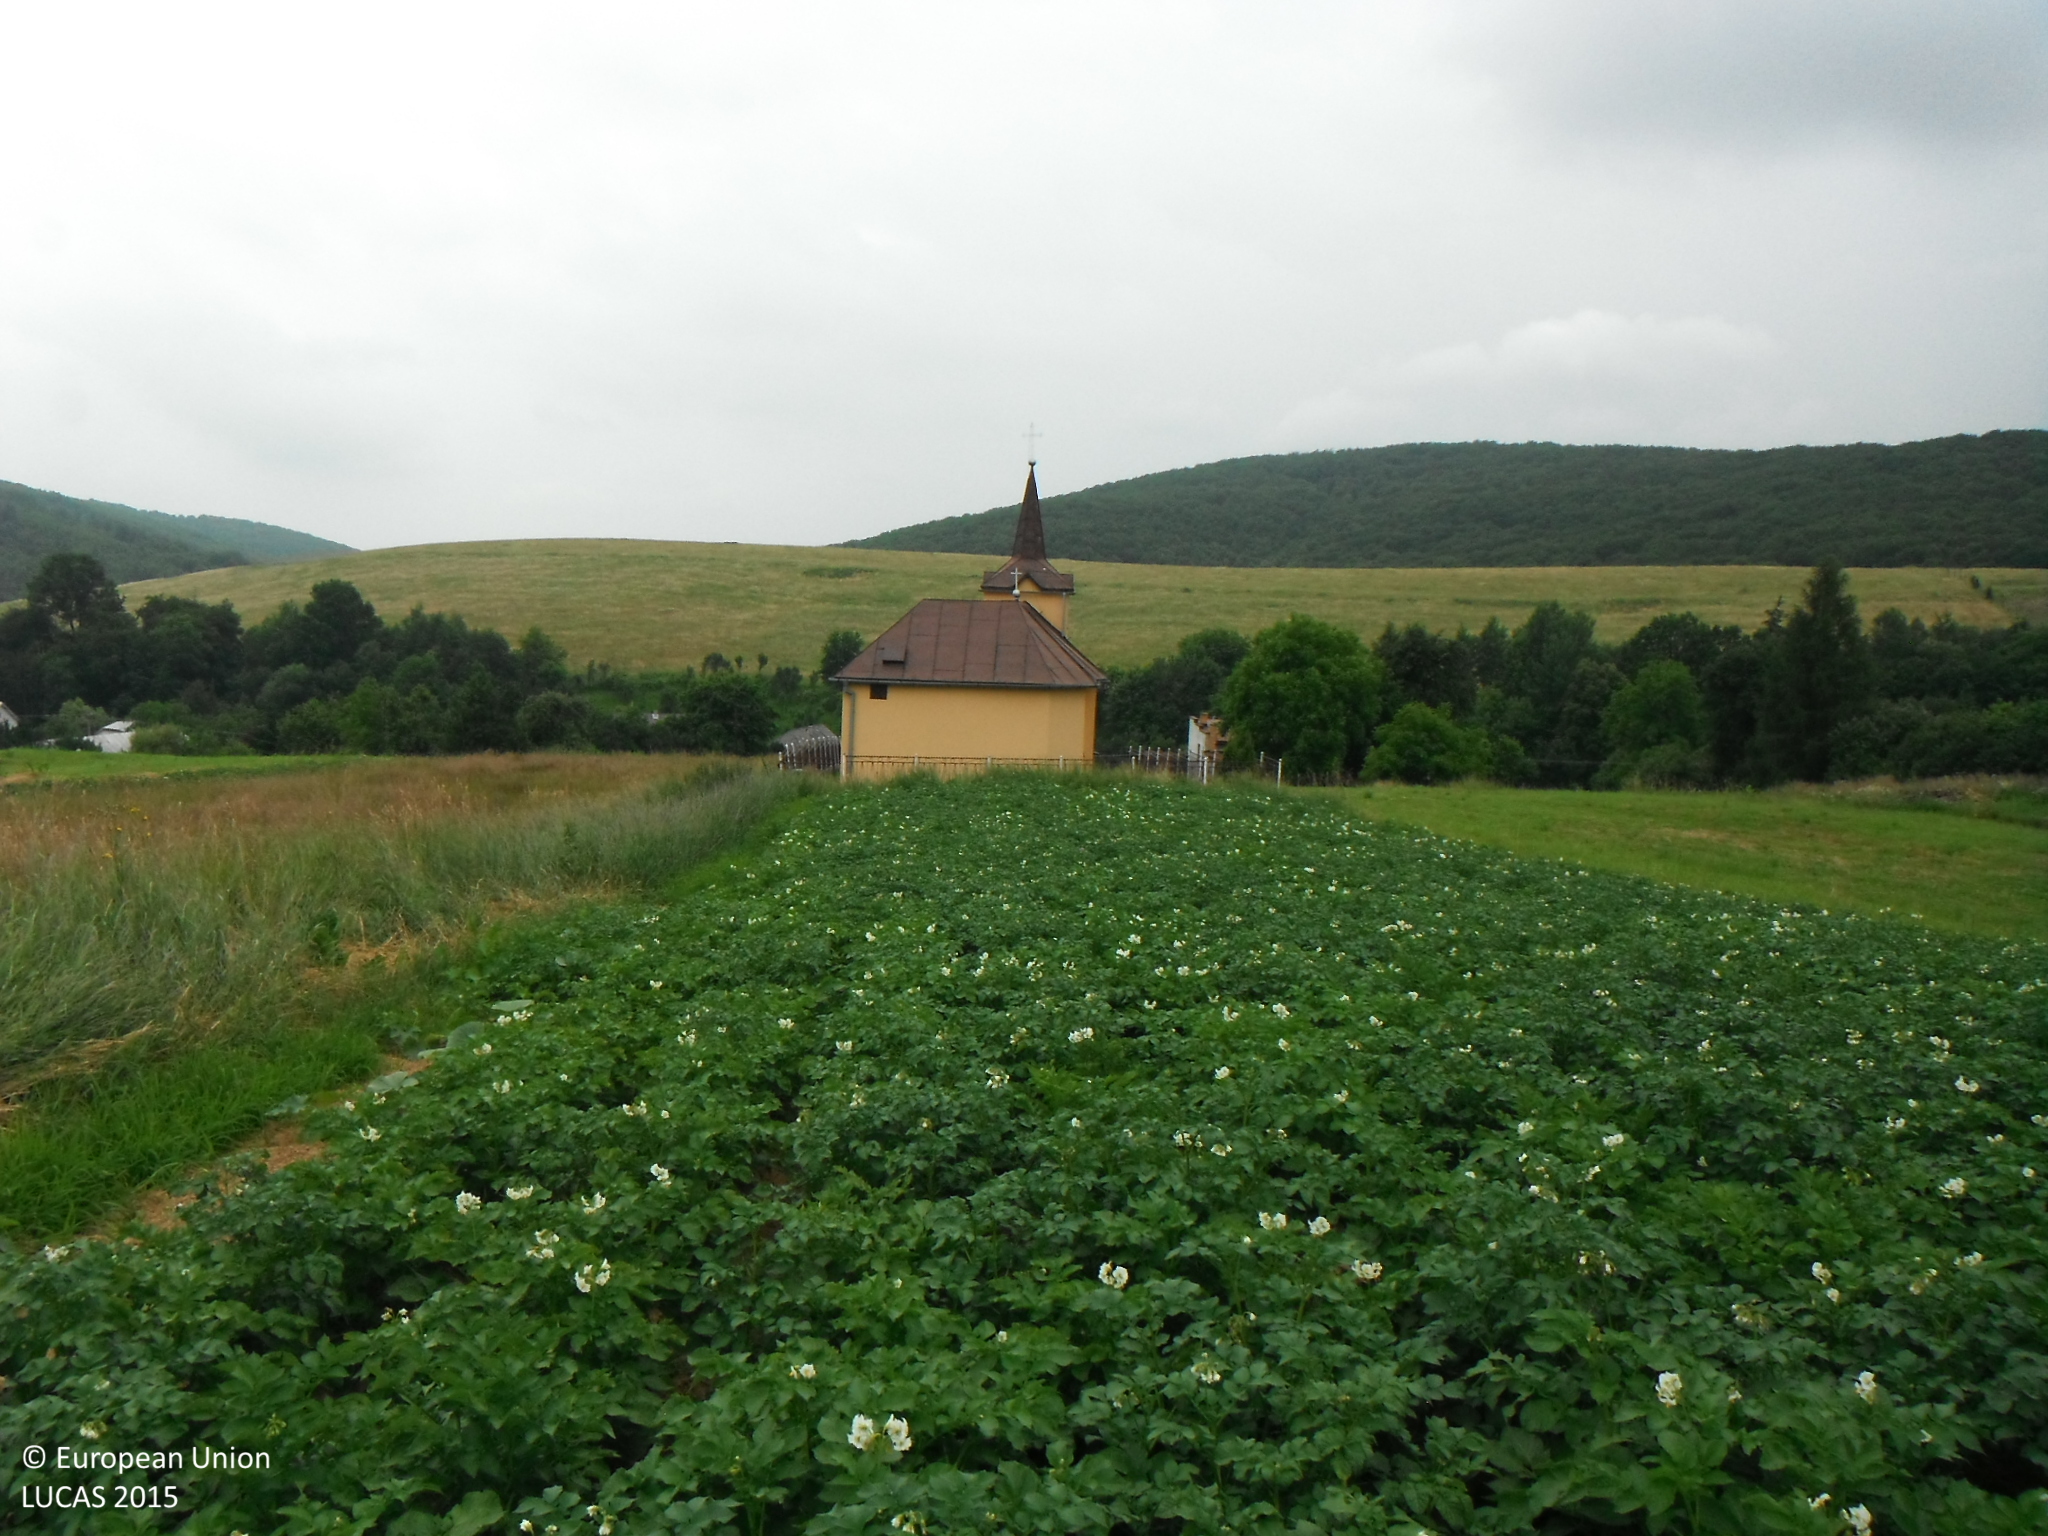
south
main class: Cropland
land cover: Potatoes
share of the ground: > 75 %
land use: Agriculture (excluding fallow land and kitchen gardens)
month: June
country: SK
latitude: 49.1883
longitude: 21.6171
